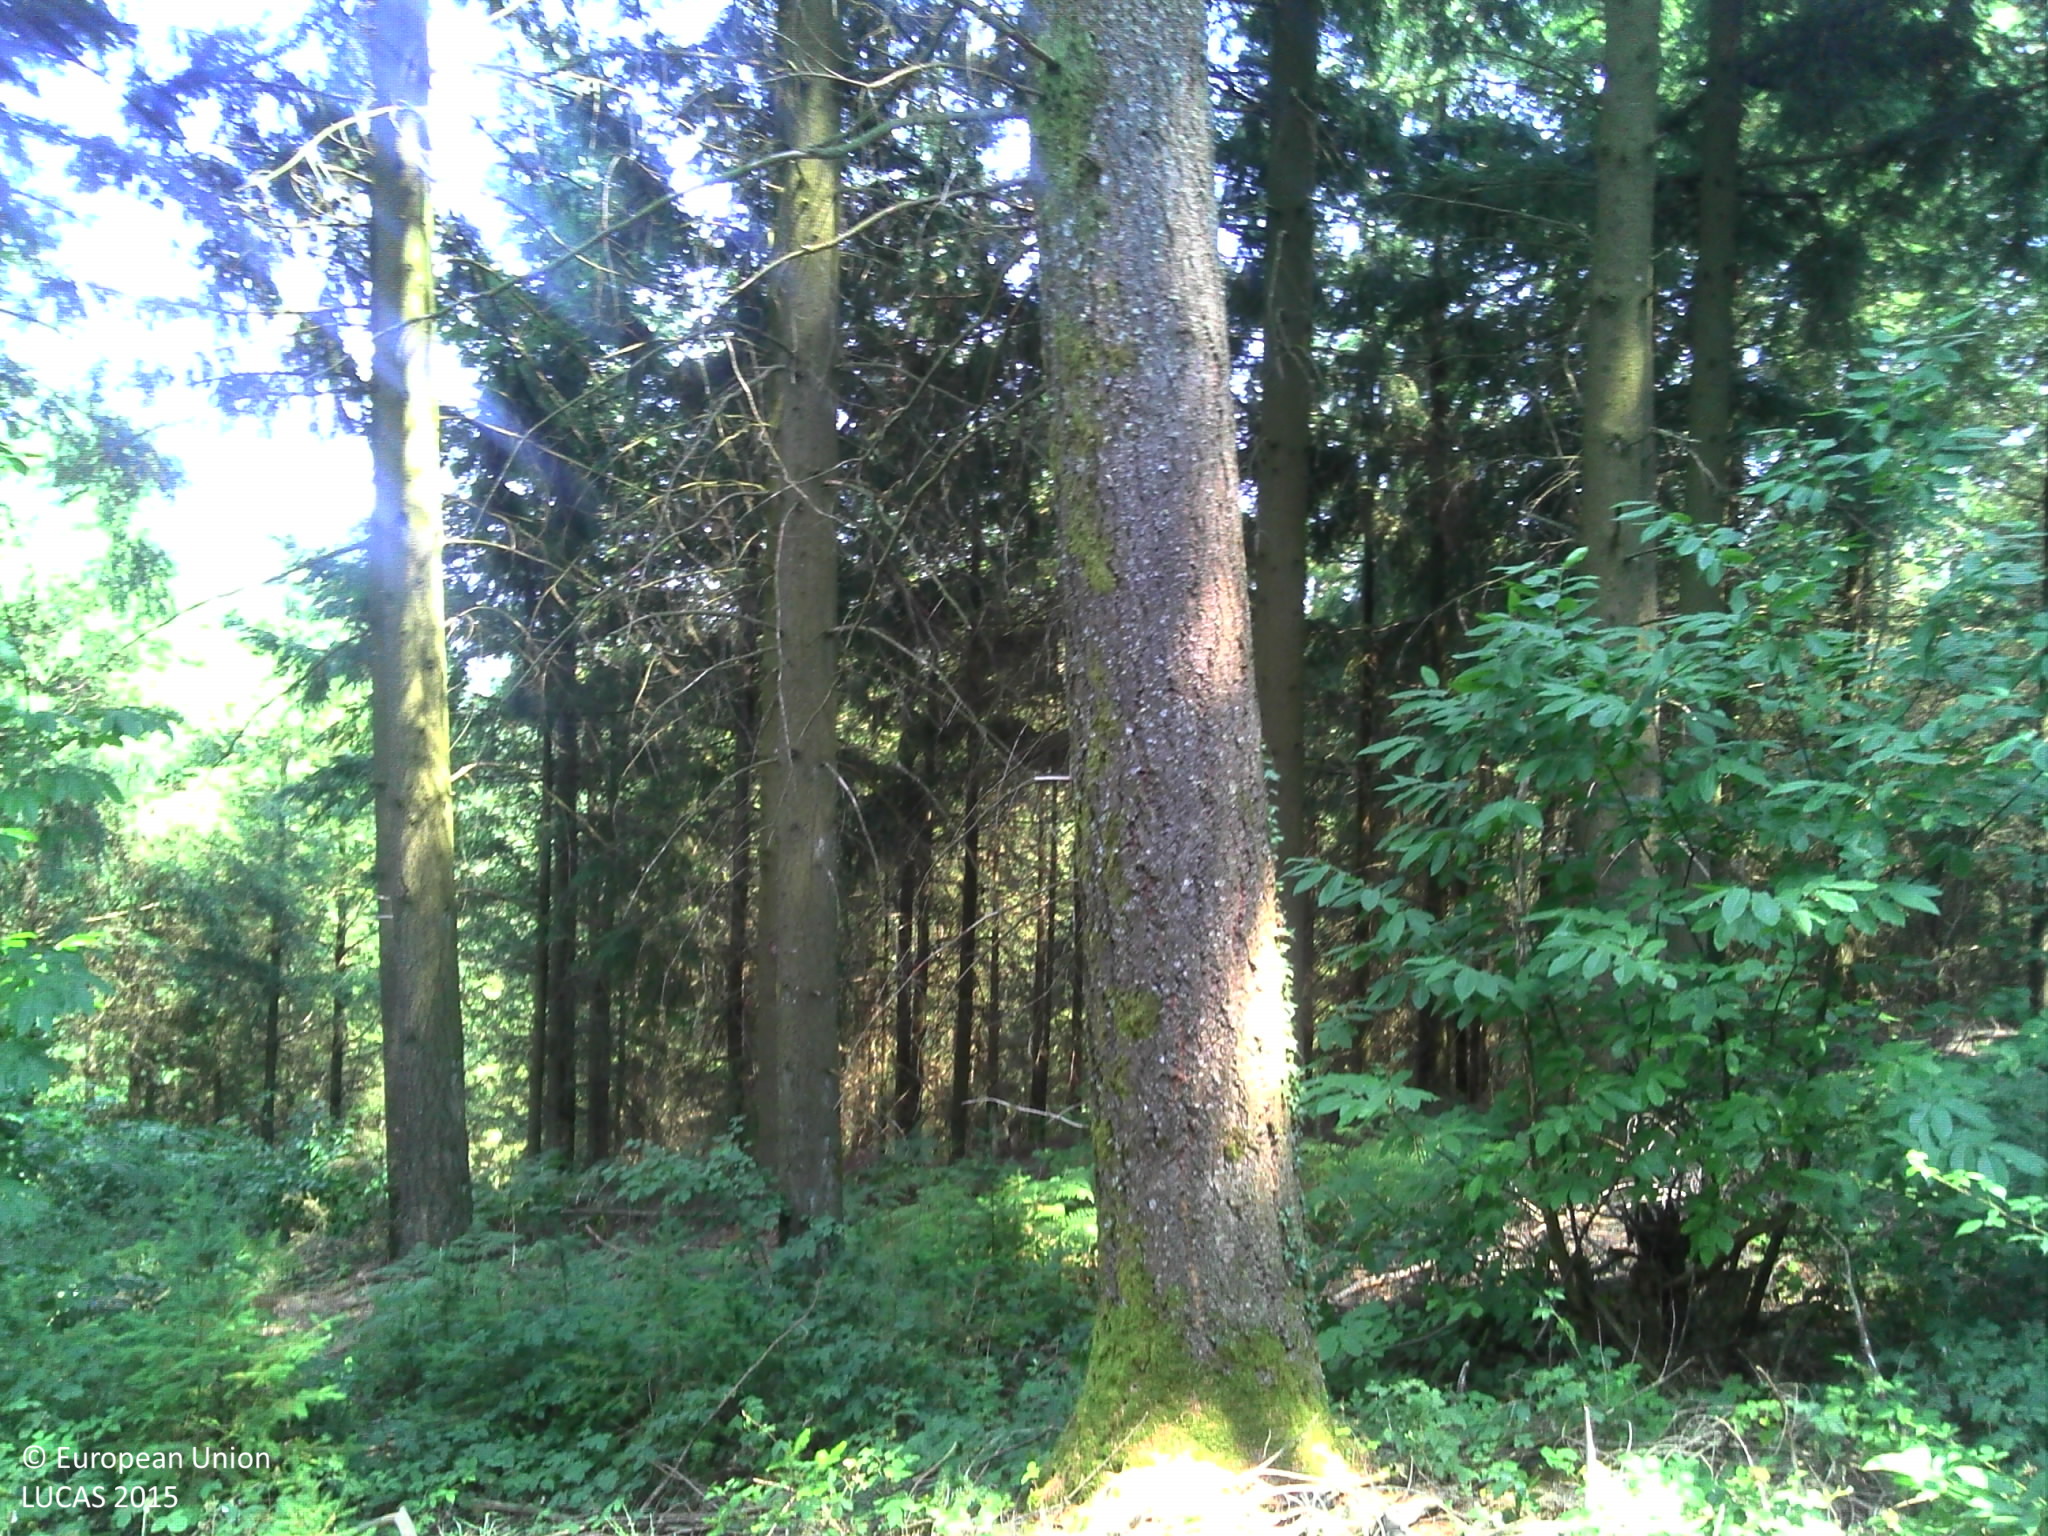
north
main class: Woodland
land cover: Spruce dominated coniferous woodland
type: exotic forest
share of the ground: > 75 %
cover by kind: coniferous forest trees 60 %, broadleaved forest trees 15 %, shrubs 10 %, lichens and mosses 10 %, herbaceous plants 5 %
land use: Forestry
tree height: > 5 m
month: July
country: FR
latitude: 45.9616
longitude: 1.7738
